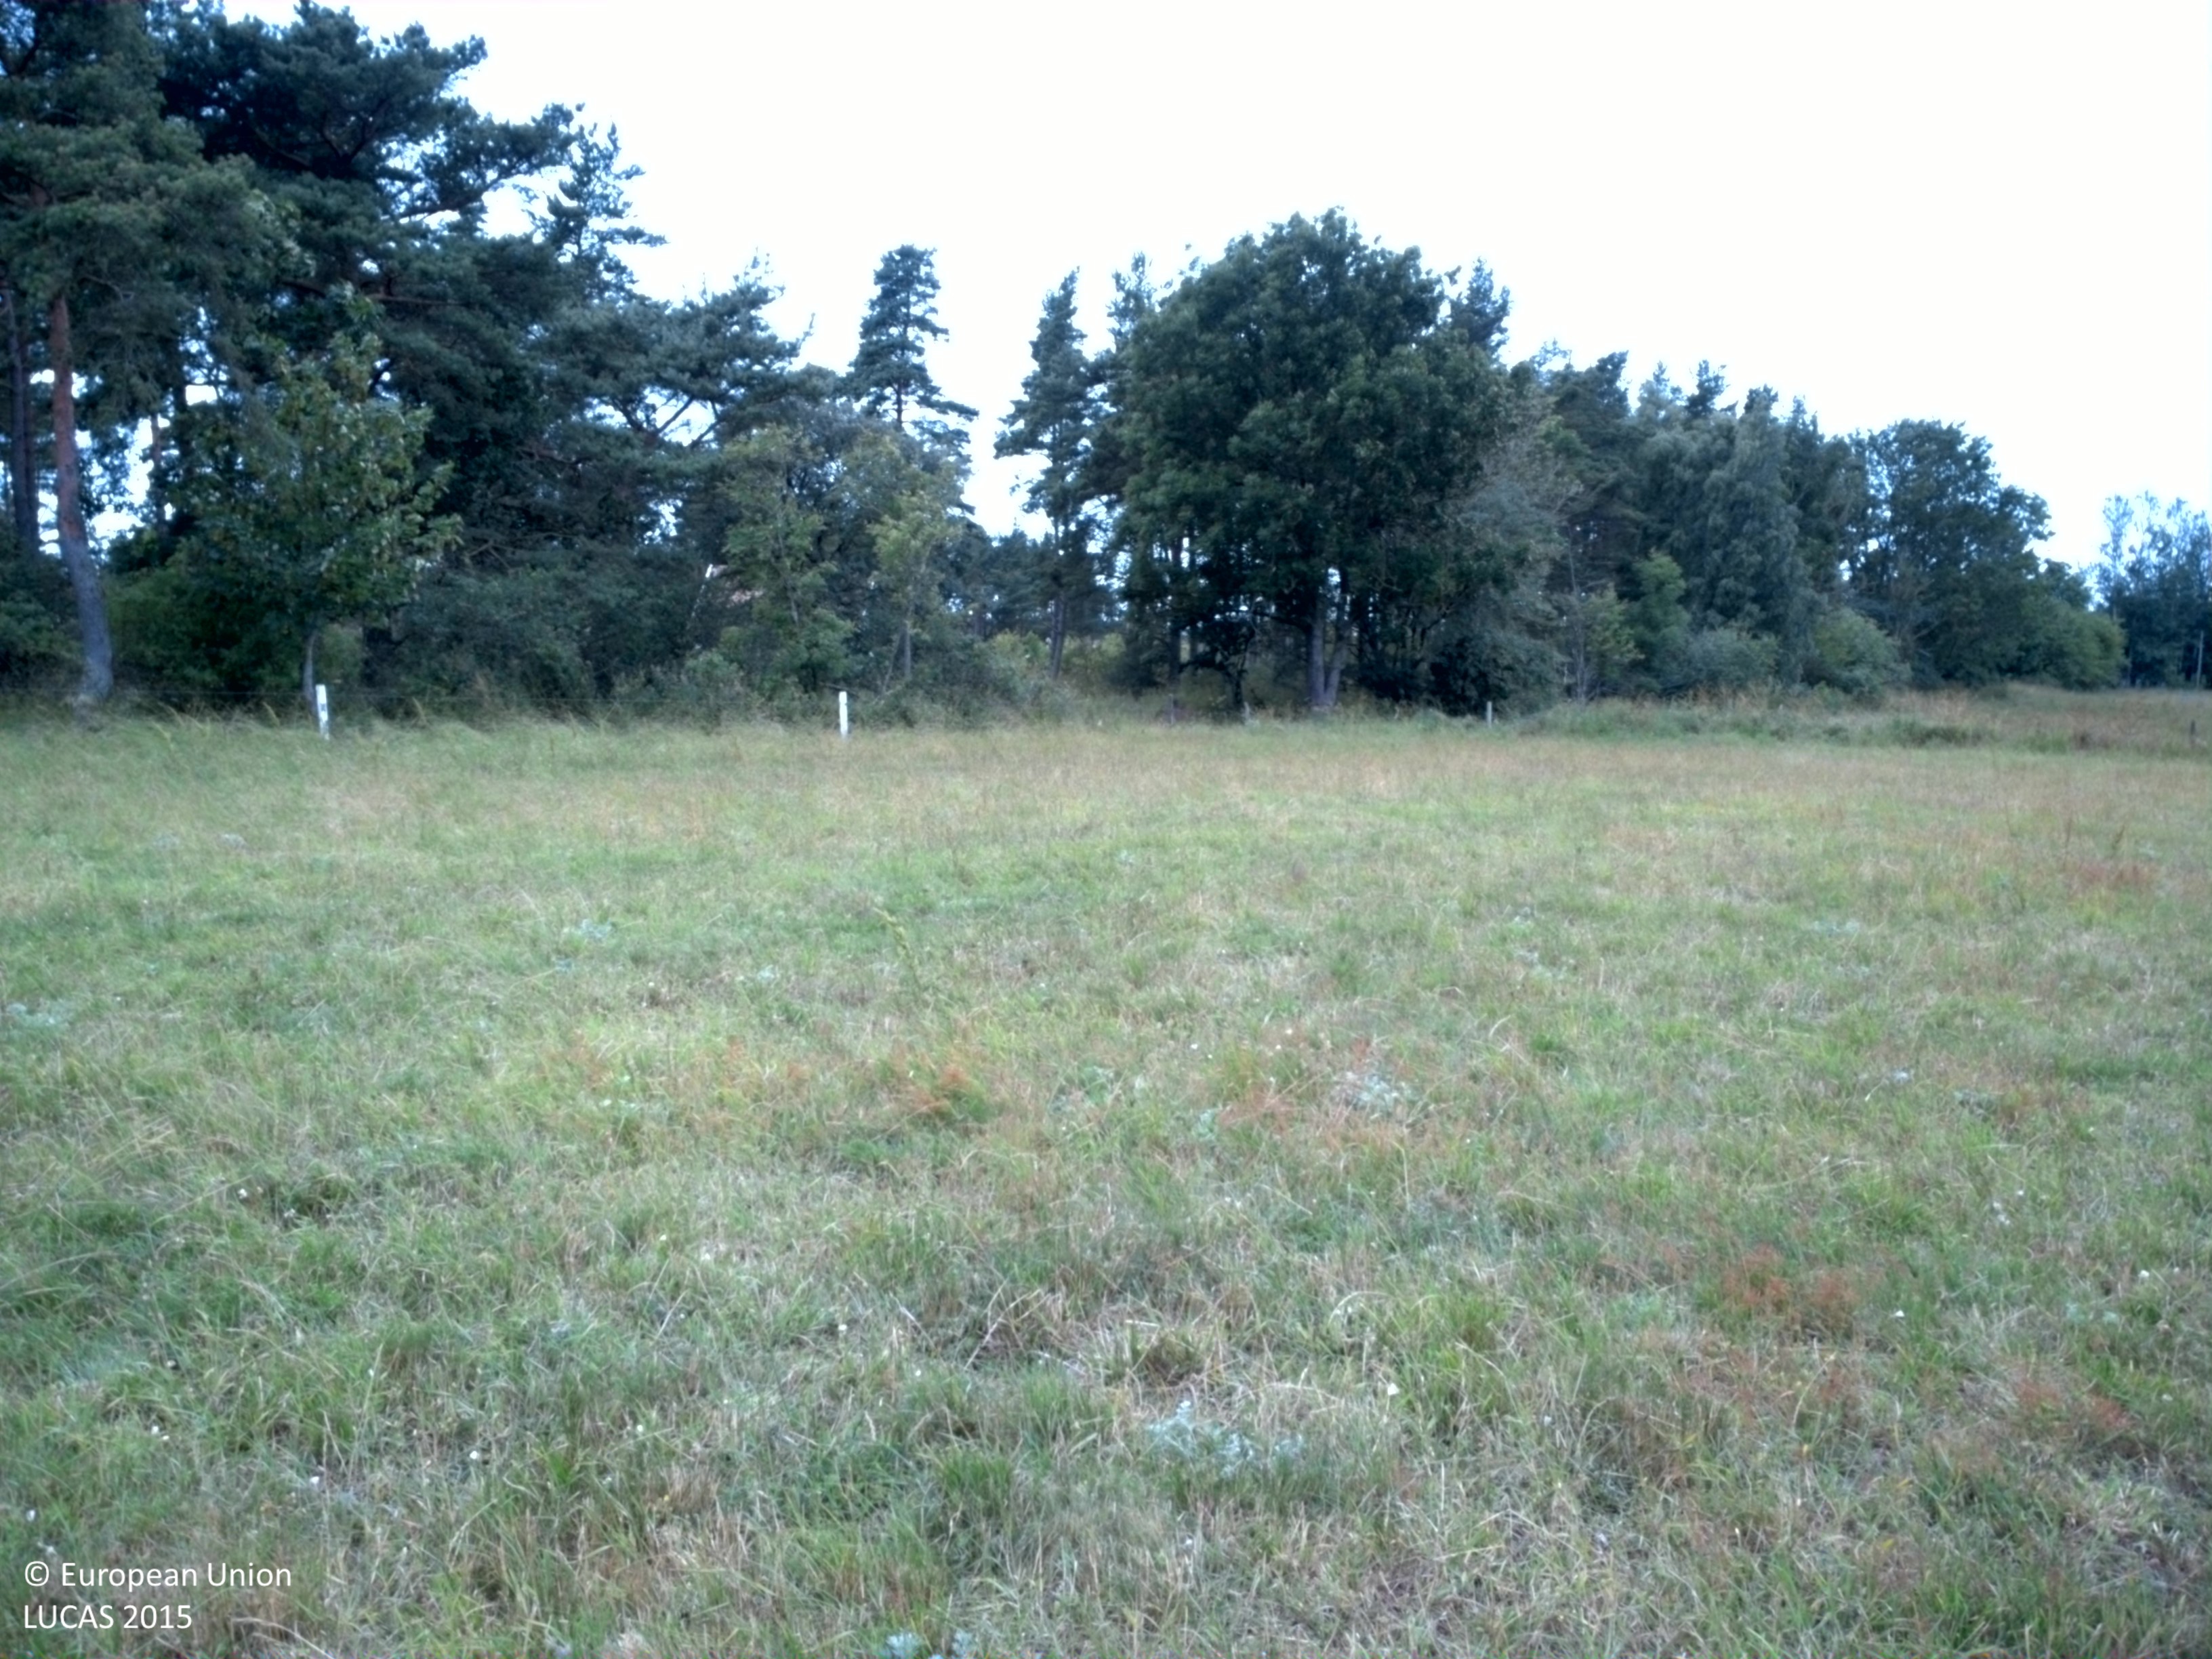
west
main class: Grassland
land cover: Grassland without tree/shrub cover
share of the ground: > 75 %
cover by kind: herbaceous plants 100 %
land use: Agriculture (excluding fallow land and kitchen gardens)
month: July
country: SE
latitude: 57.4470
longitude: 18.1549
